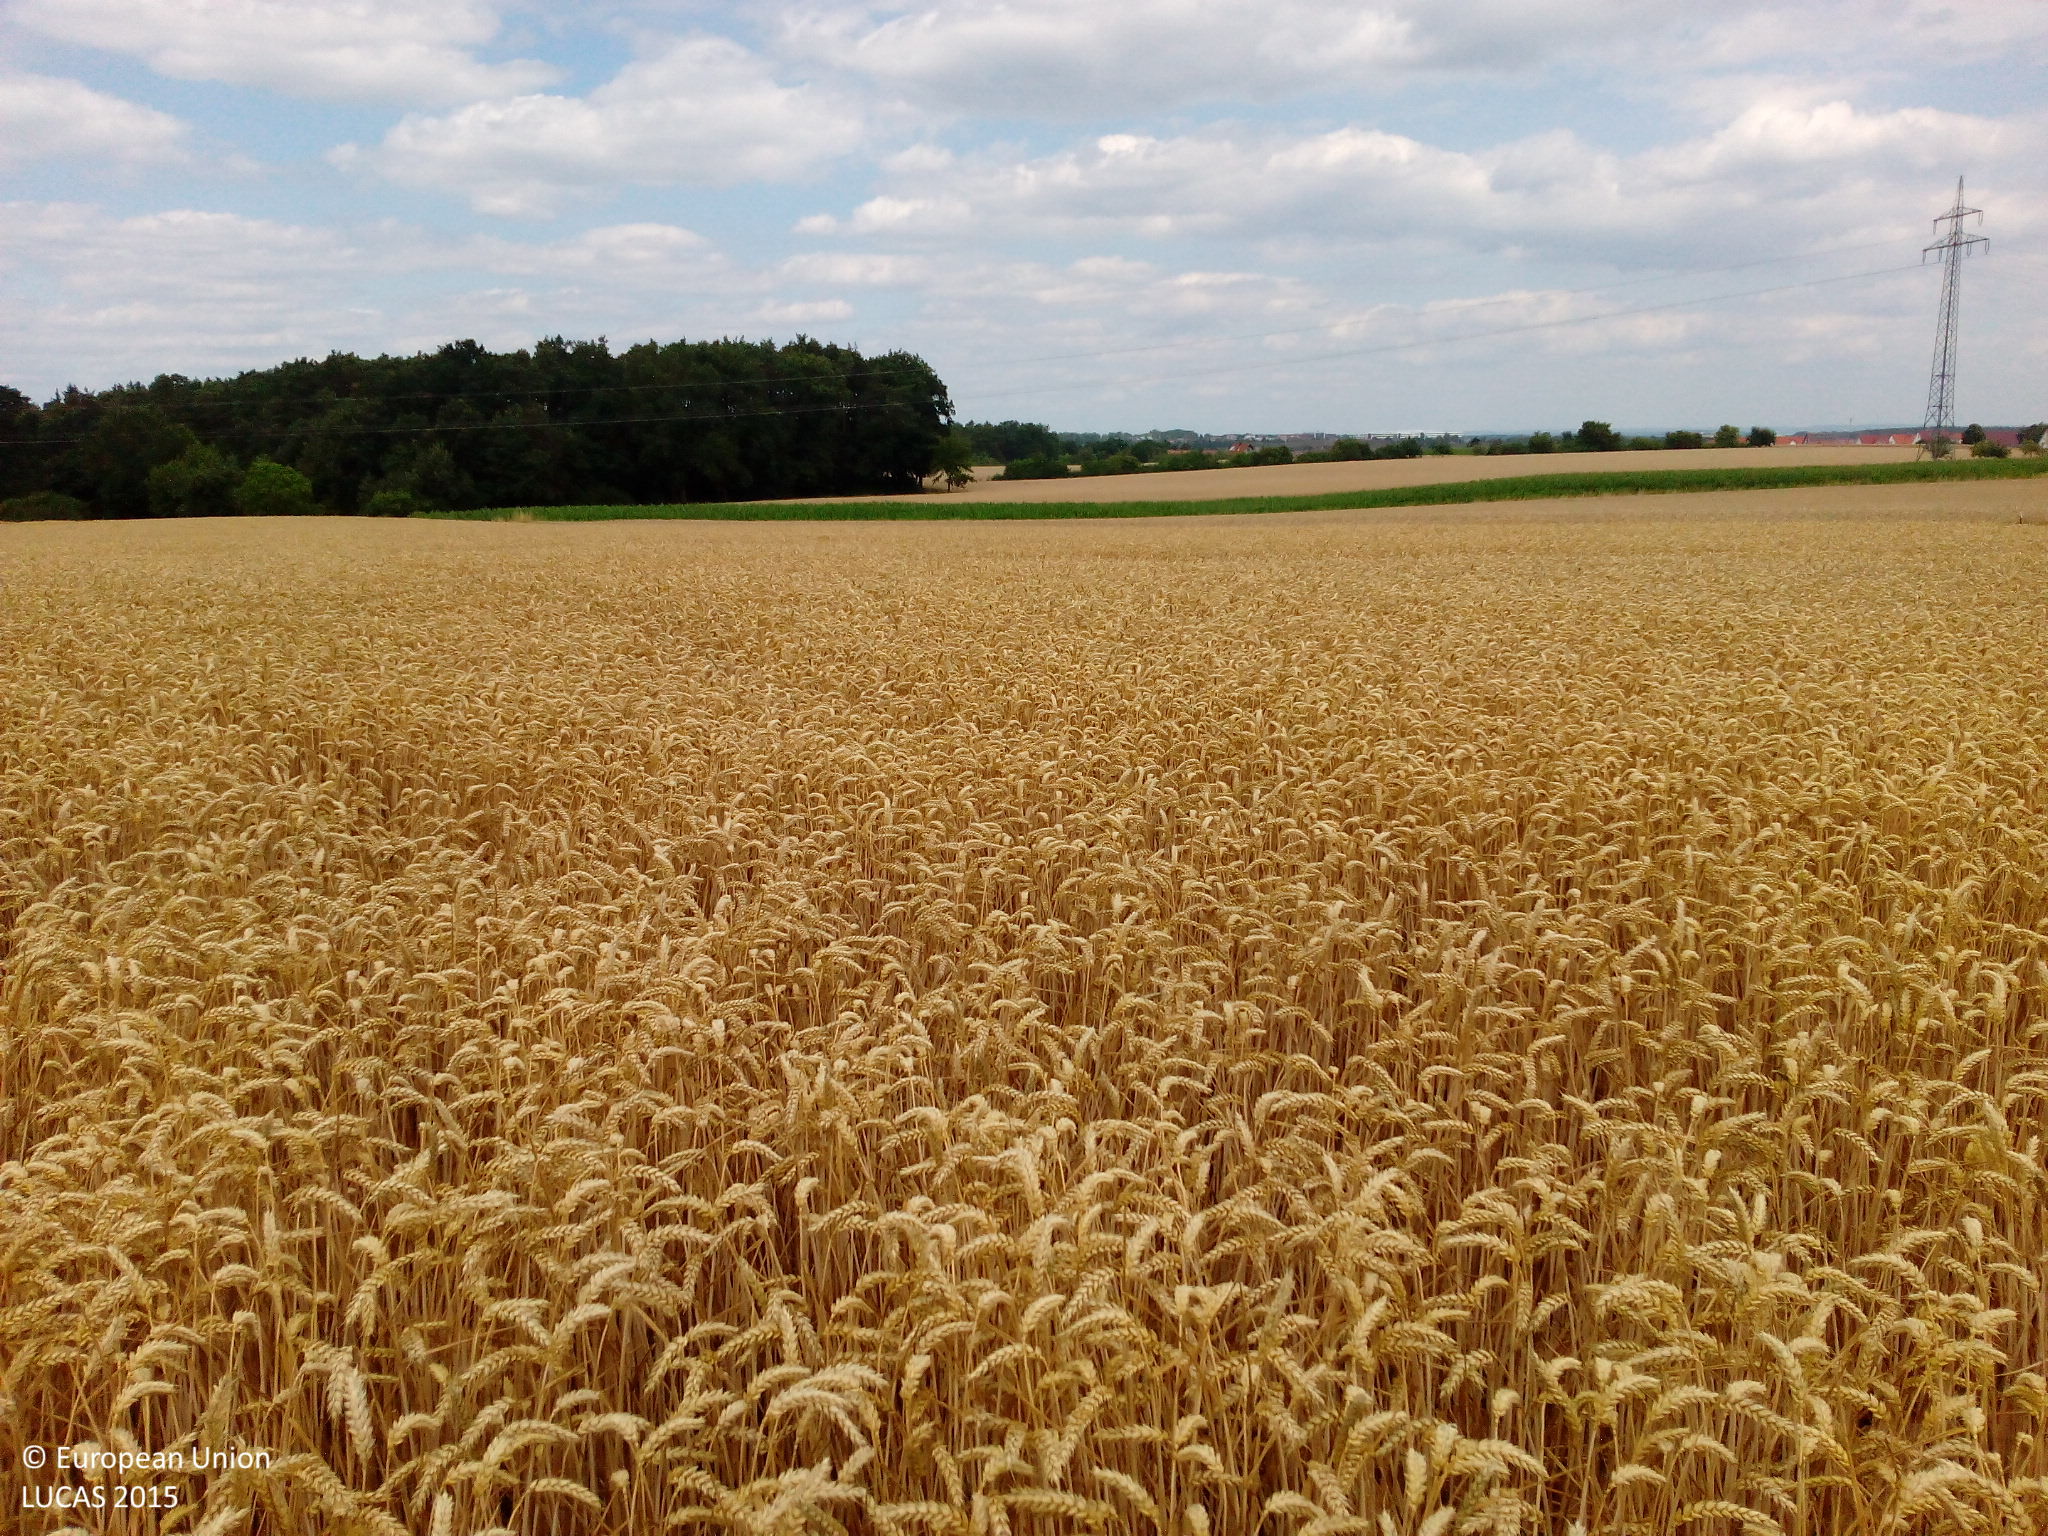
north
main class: Cropland
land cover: Common wheat
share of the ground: > 75 %
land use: Agriculture (excluding fallow land and kitchen gardens)
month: July
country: DE
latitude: 49.5512
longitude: 10.8981
